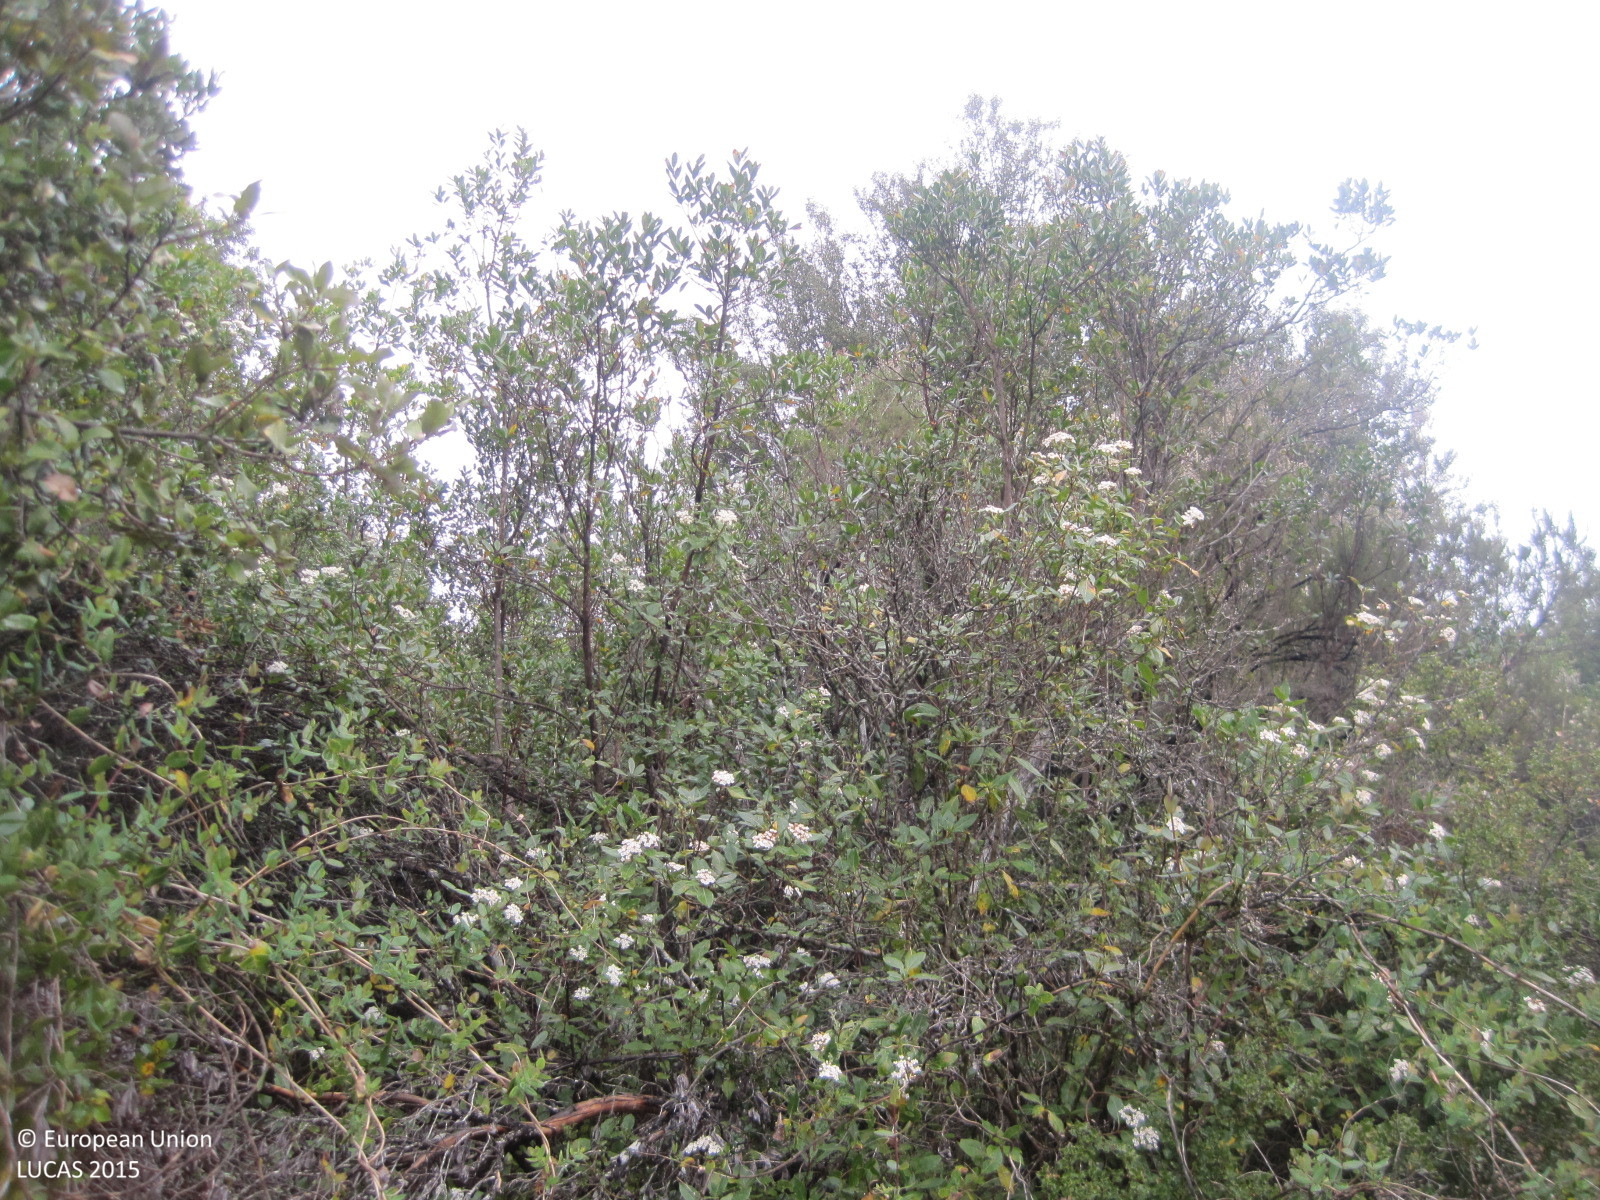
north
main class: Woodland
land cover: Broadleaved woodland
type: broadleaved evergreen forest
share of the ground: > 75 %
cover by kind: broadleaved forest trees 100 %
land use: Forestry
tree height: > 5 m
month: April
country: ES
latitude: 42.6784
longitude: -2.2107
